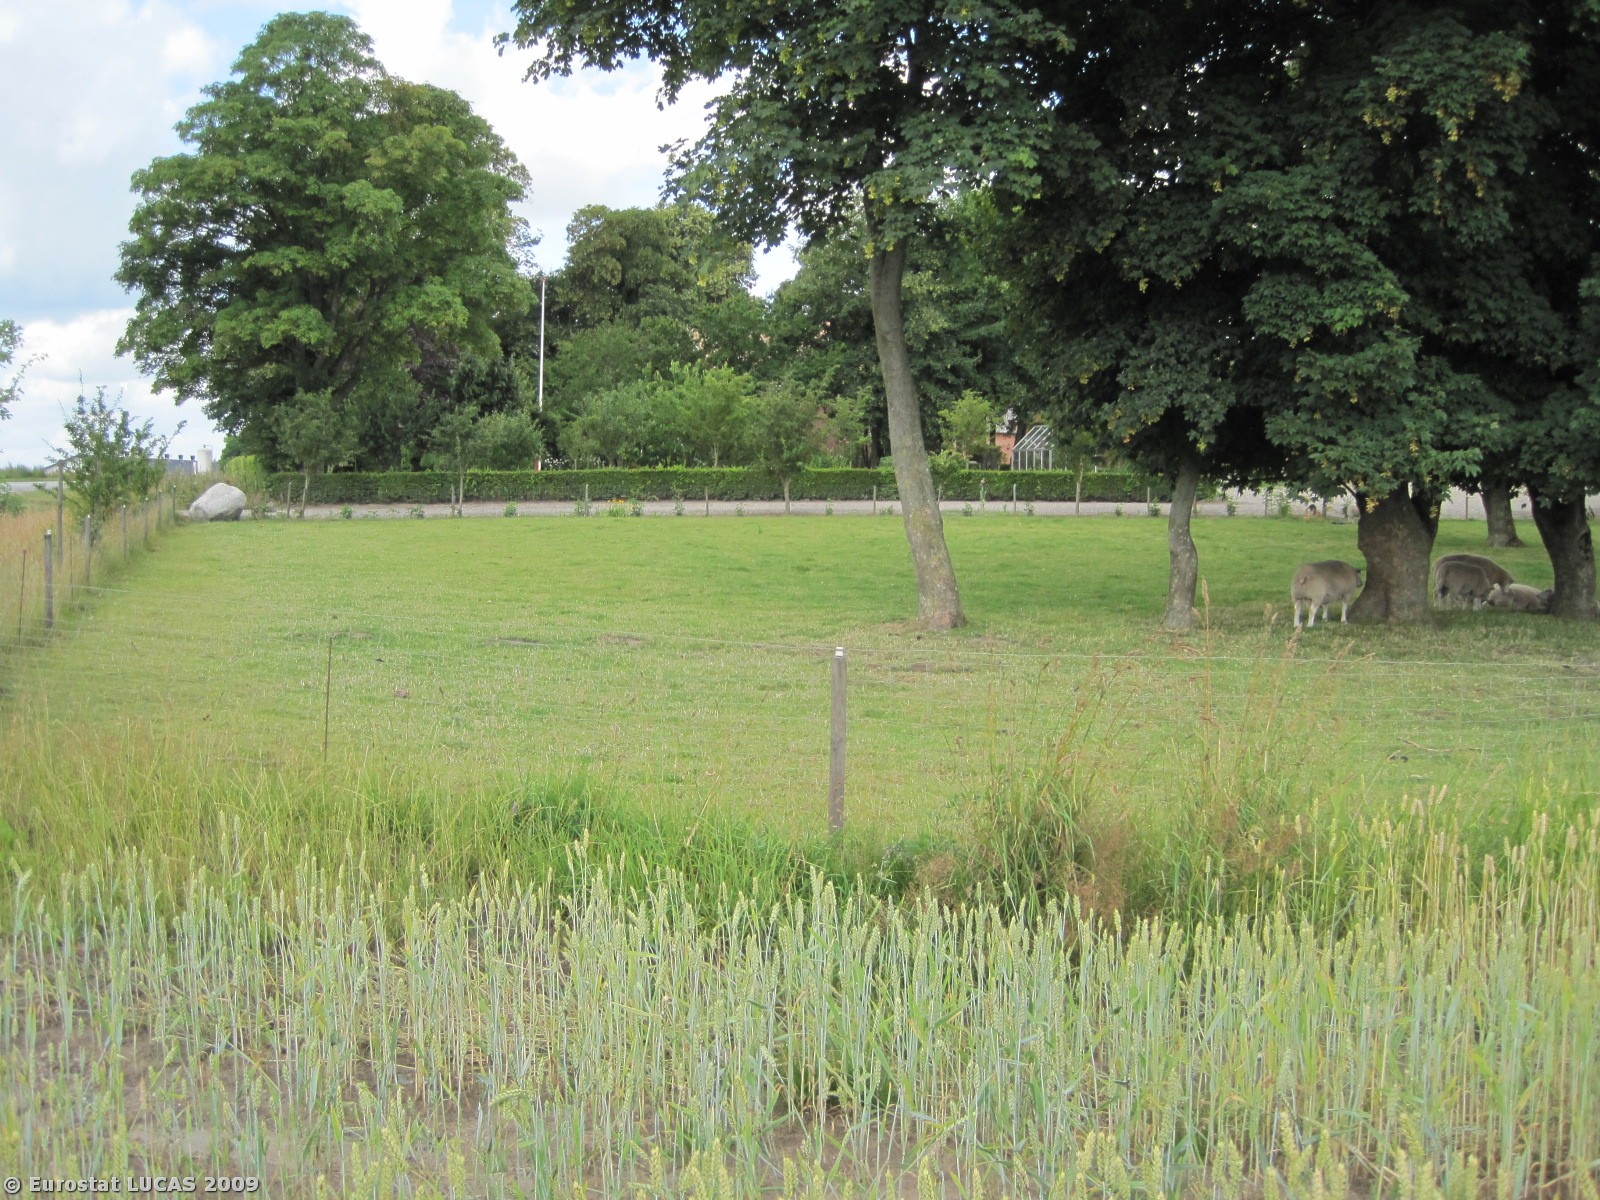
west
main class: Cropland
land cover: Common wheat
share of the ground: > 75 %
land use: Agriculture (excluding fallow land and kitchen gardens)
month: July
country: DK
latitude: 56.6727
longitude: 9.6904
